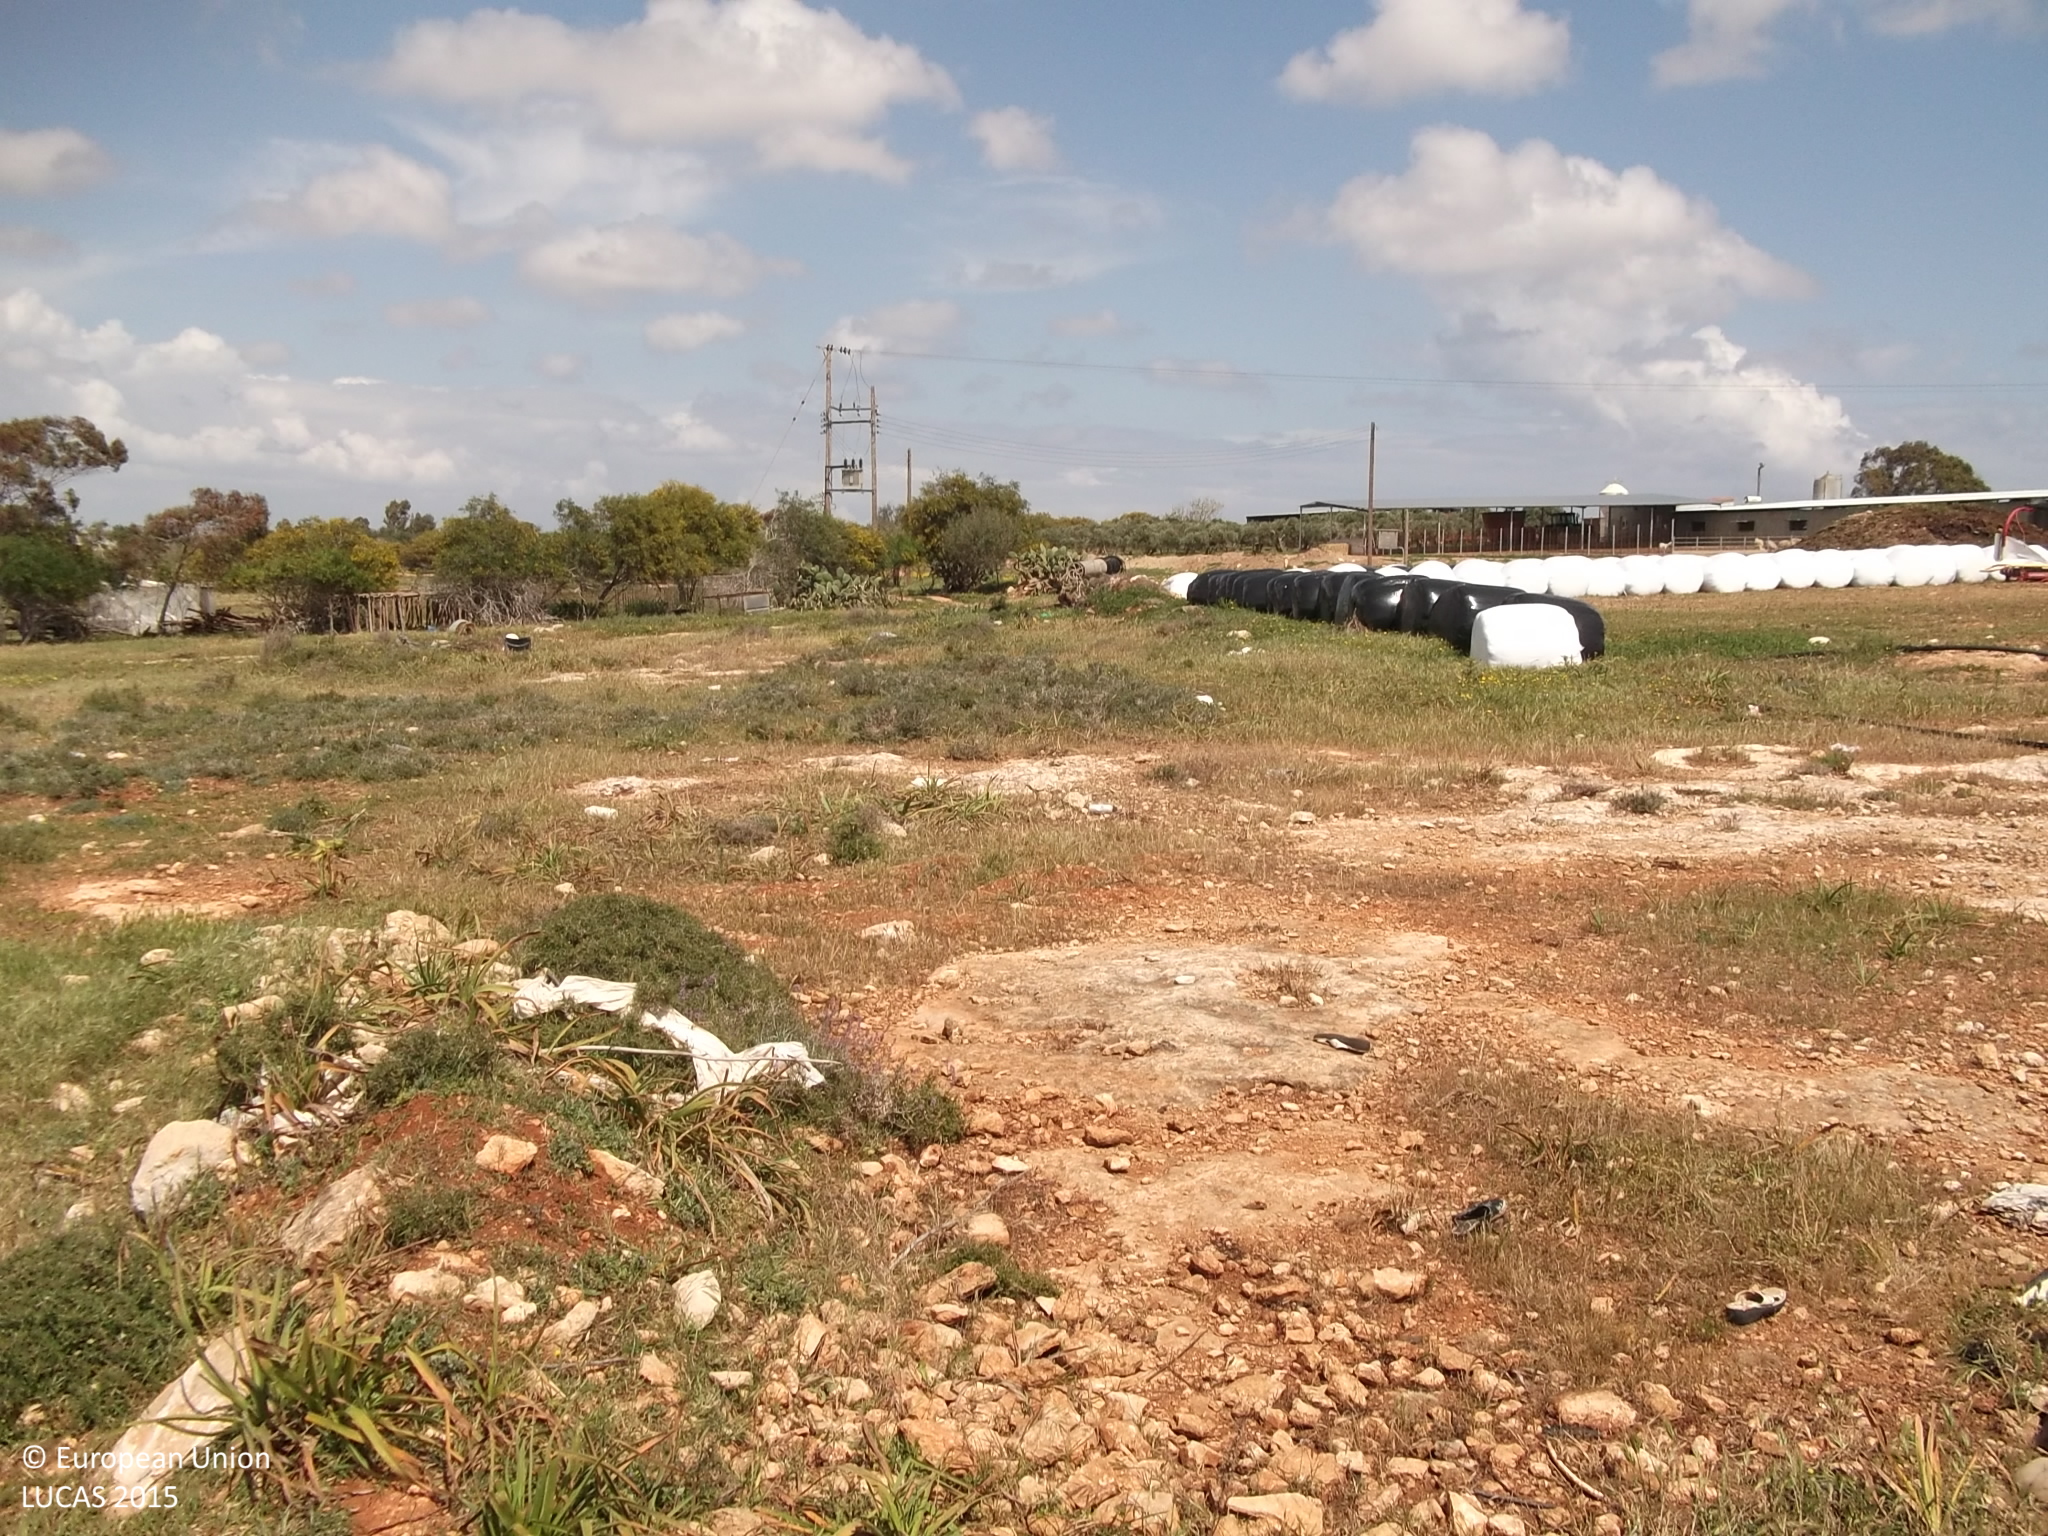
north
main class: Shrubland
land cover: Shrubland without tree cover
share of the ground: 50 - 75 %
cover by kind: shrubs 50 %, herbaceous plants 30 %, consolidated bare surface 10 %, unconsolidated bare surface 10 %
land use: Agriculture (excluding fallow land and kitchen gardens)
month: March
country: CY
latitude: 35.0125
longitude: 33.9608
